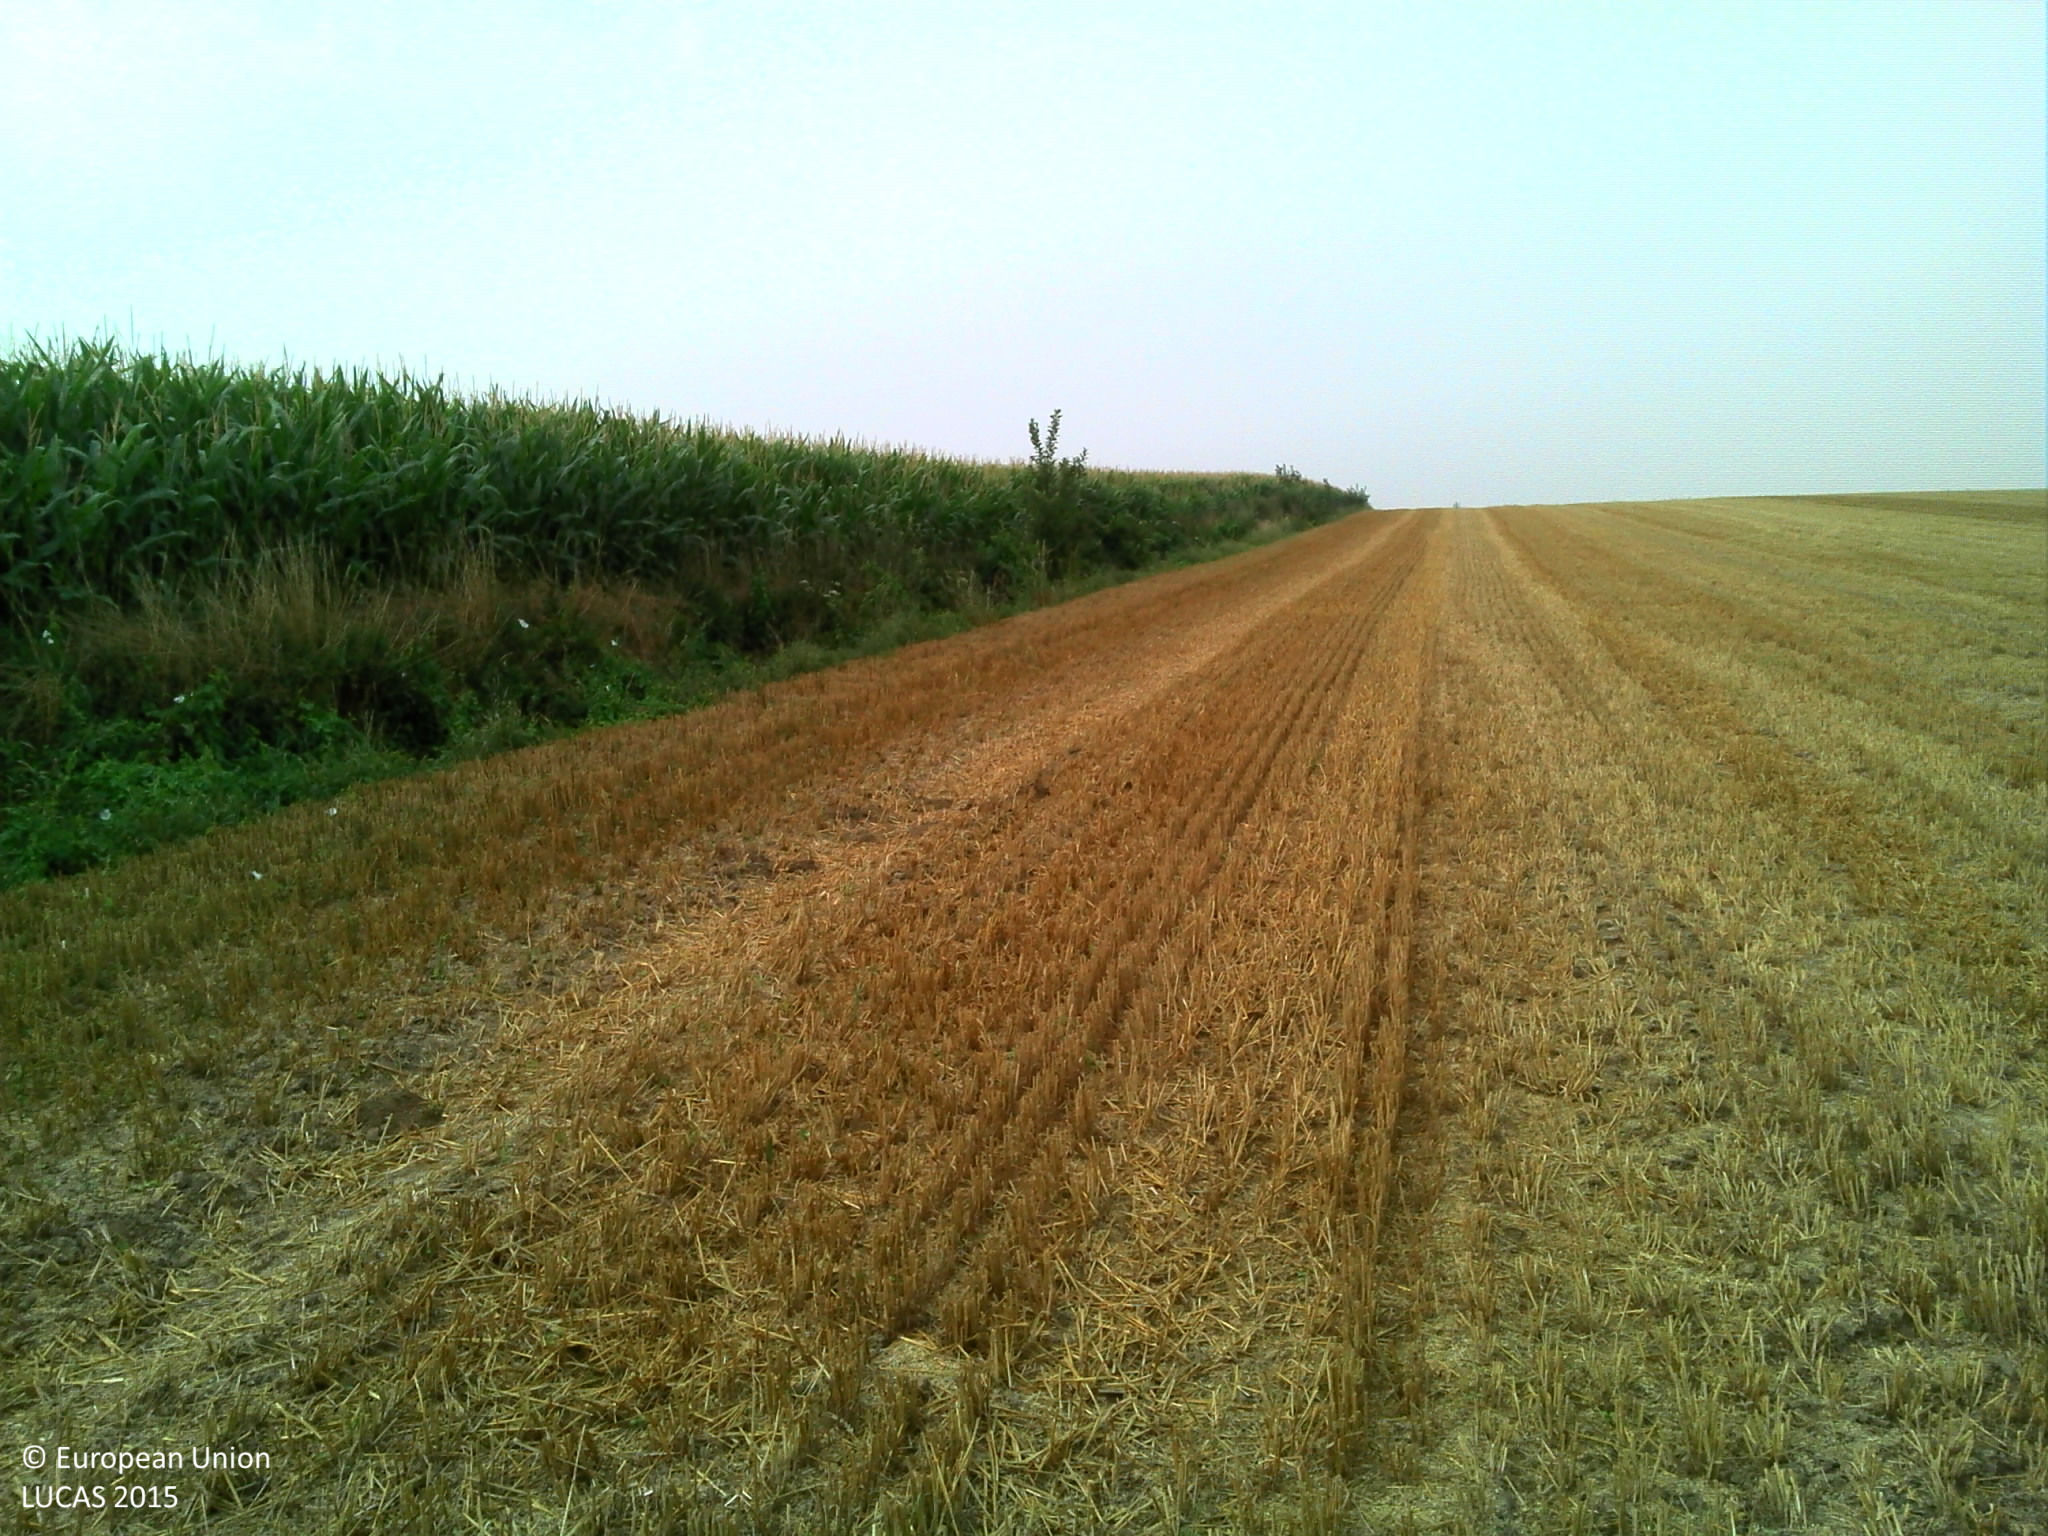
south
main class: Cropland
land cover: Common wheat
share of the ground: > 75 %
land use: Agriculture (excluding fallow land and kitchen gardens)
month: August
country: BE
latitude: 50.6645
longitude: 3.4700
